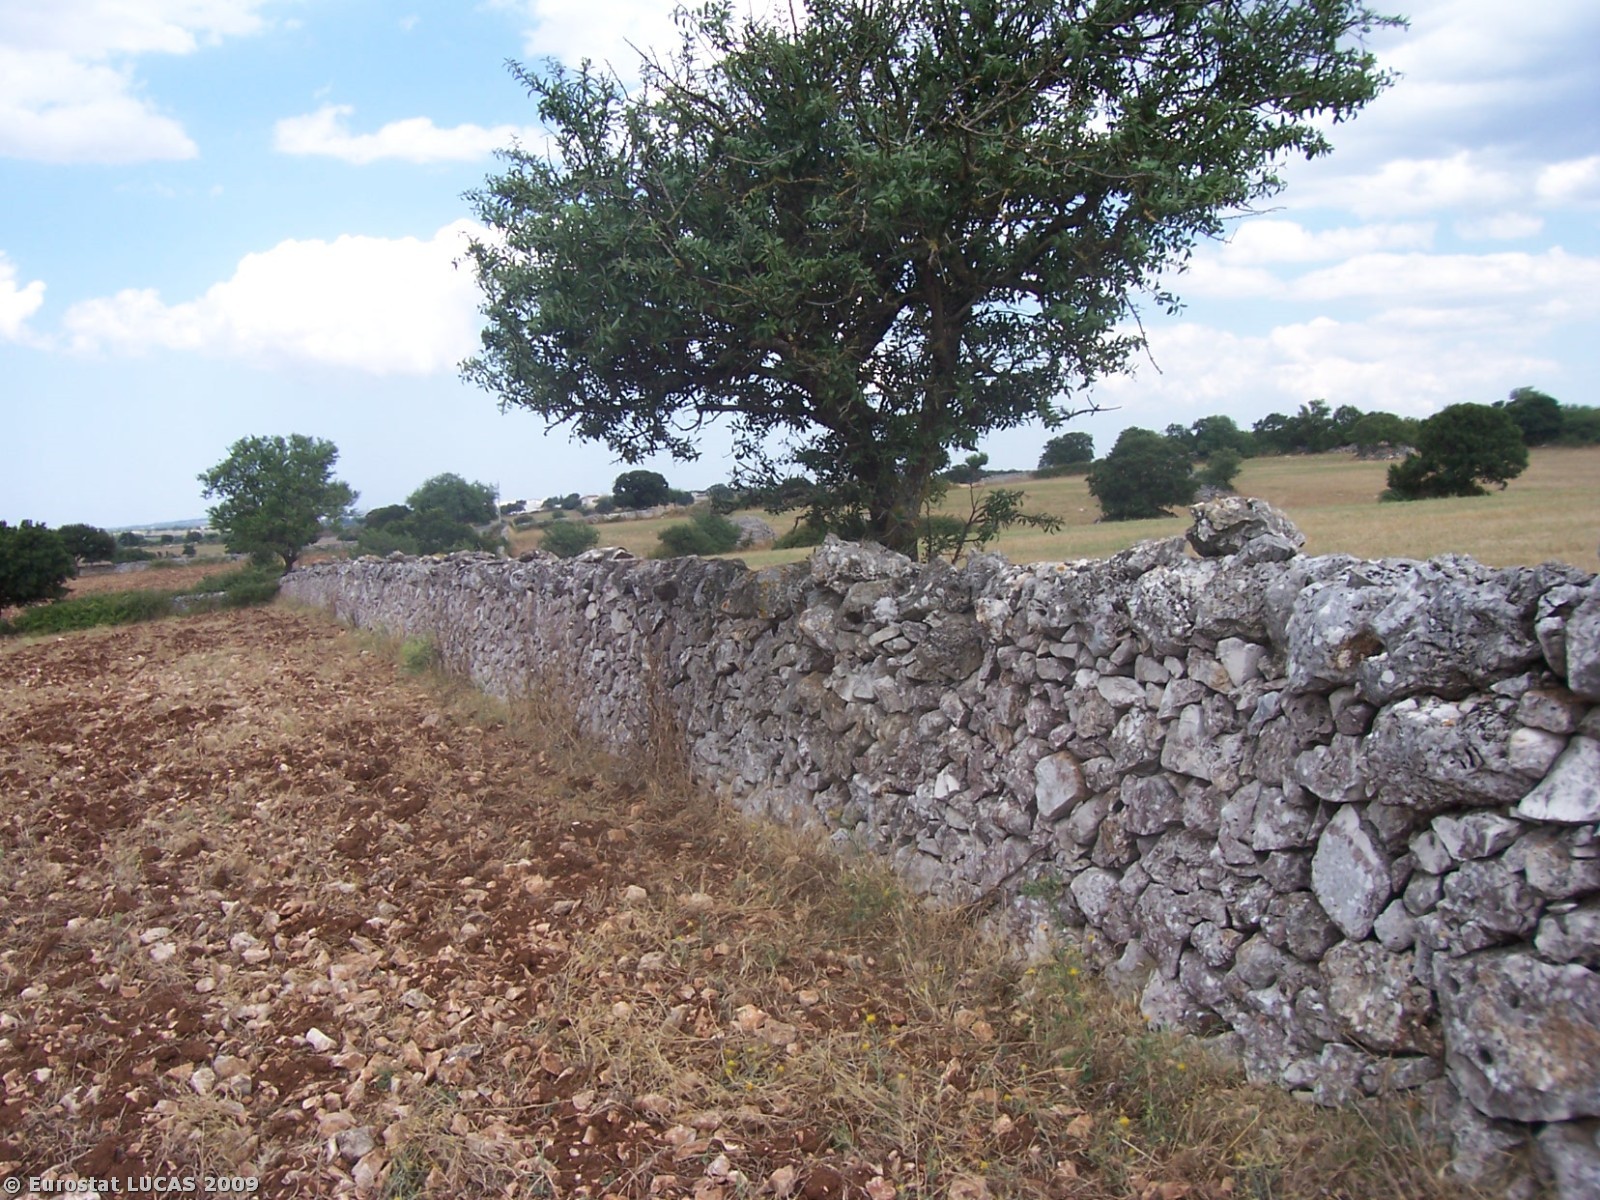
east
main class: Cropland
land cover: Temporary grasslands
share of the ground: < 10 %
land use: Agriculture (excluding fallow land and kitchen gardens)
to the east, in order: Temporary grasslands; Dry stone walls; Temporary grasslands; Abandoned hedges; Rock outcrops; Abandoned hedges; Temporary grasslands; Abandoned hedges; Dry stone walls; Abandoned hedges; Temporary grasslands
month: July
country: IT
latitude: 40.7776
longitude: 17.0274
